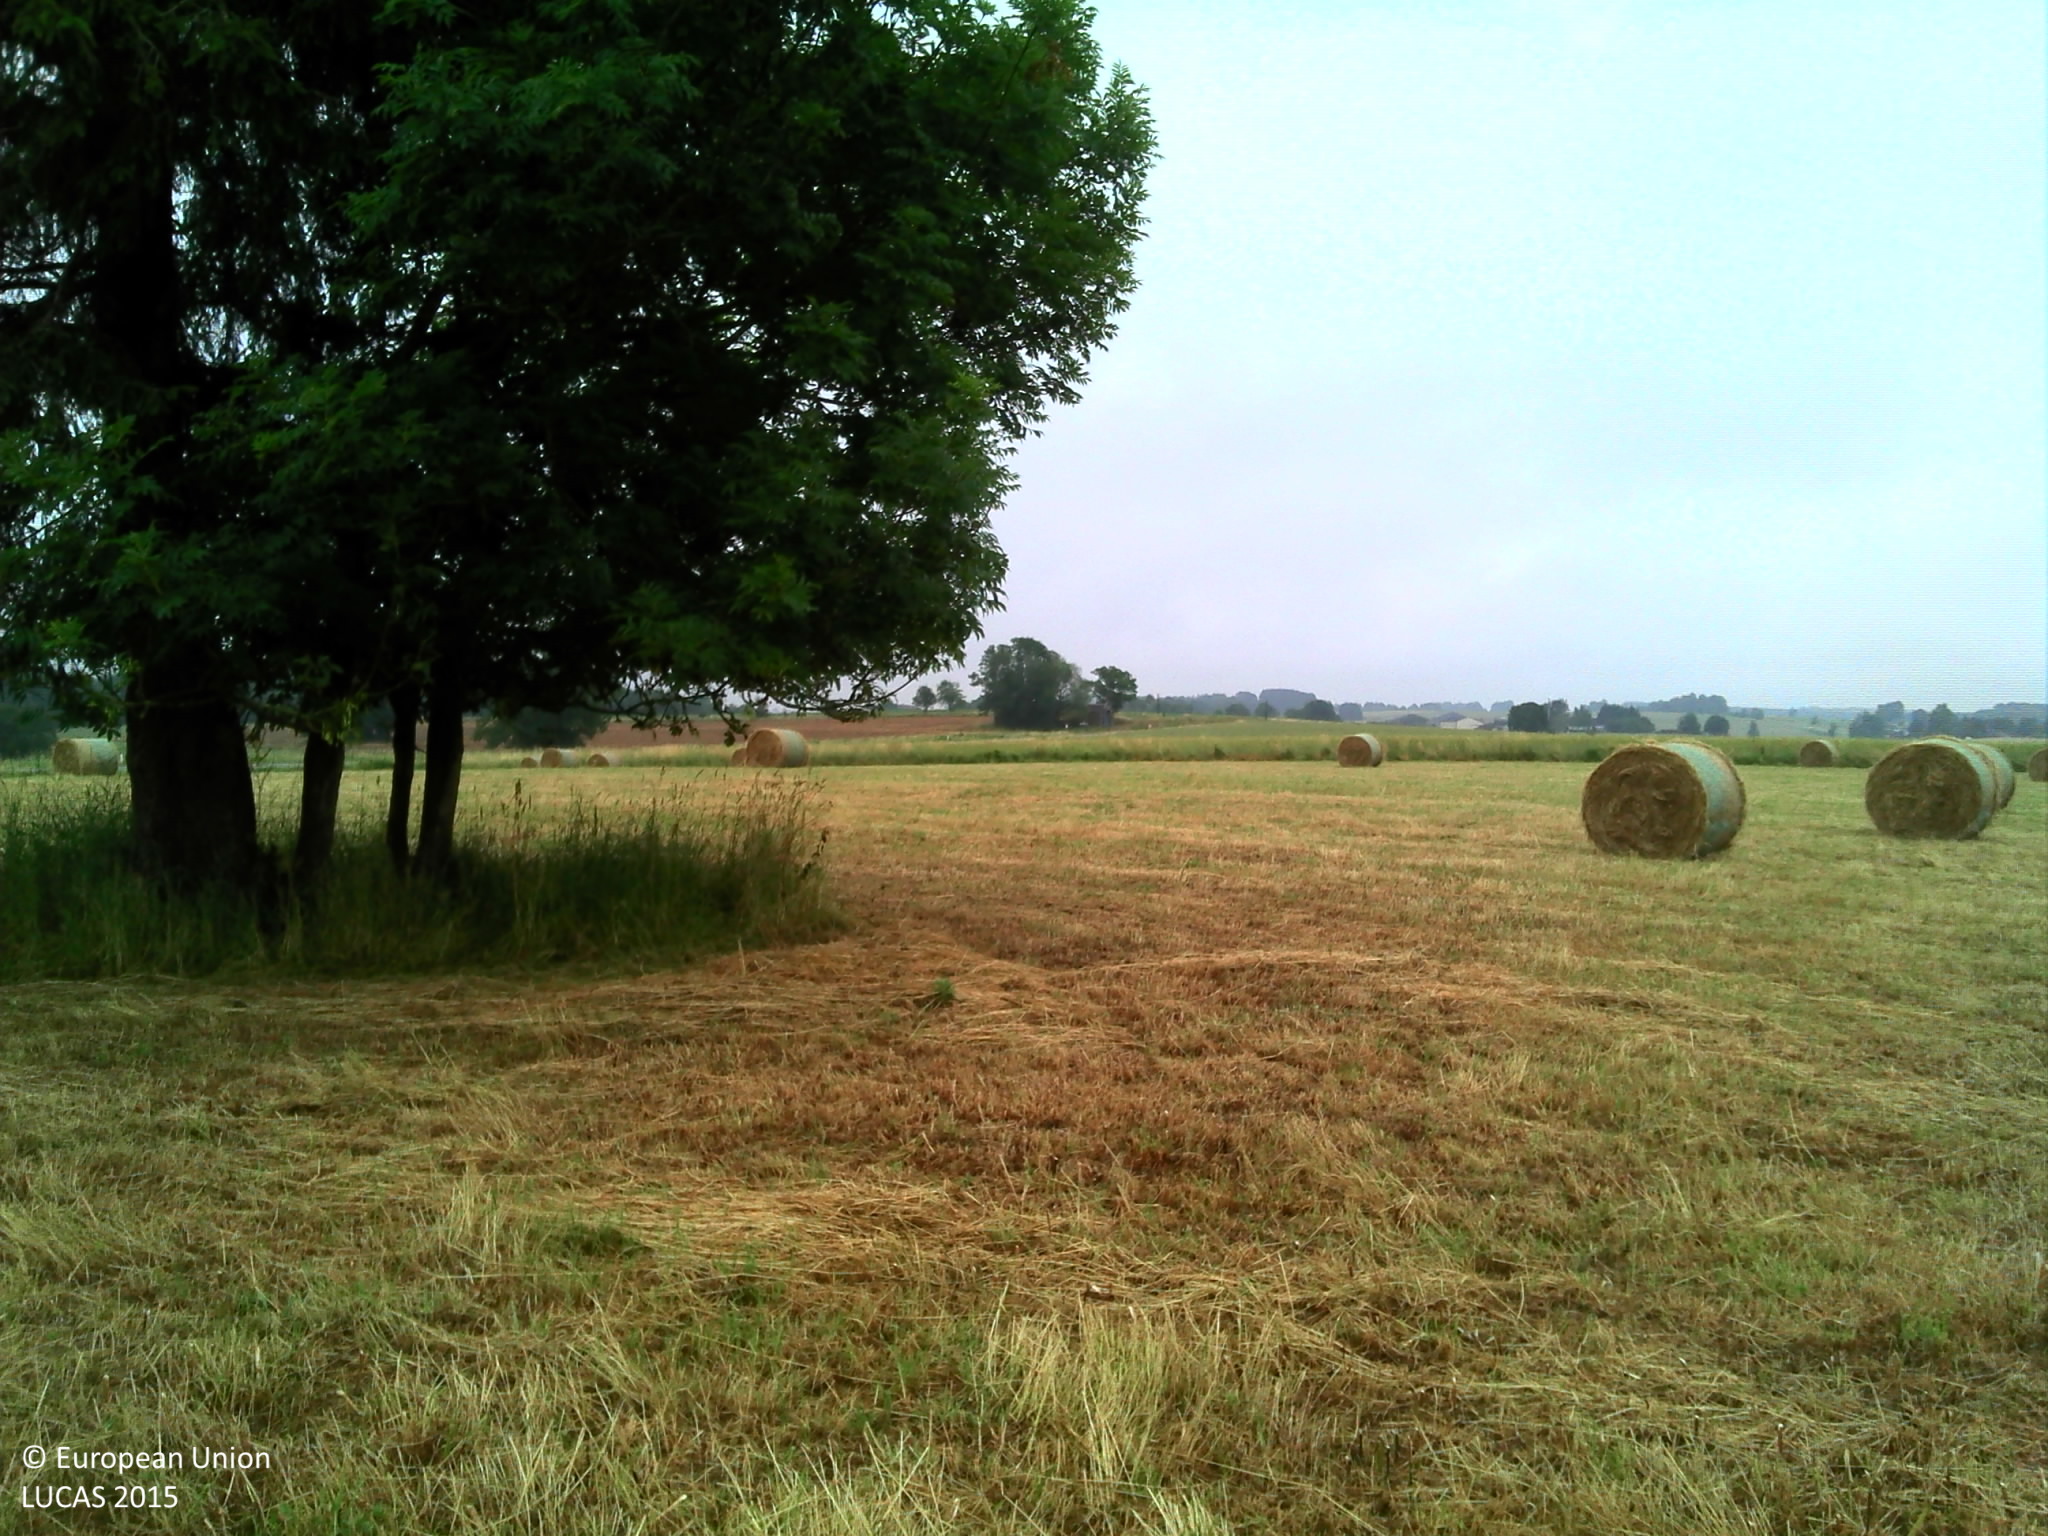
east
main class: Grassland
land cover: Grassland with sparse tree/shrub cover
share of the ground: > 75 %
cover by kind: herbaceous plants 95 %, broadleaved forest trees 5 %
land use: Agriculture (excluding fallow land and kitchen gardens)
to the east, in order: Grassland with sparse tree/shrub cover; Grassland without tree/shrub cover; Rye; Common wheat; Grass margins; Paved roads, cycling and walking lanes; Grass margins
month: July
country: BE
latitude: 49.7067
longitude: 5.2417
